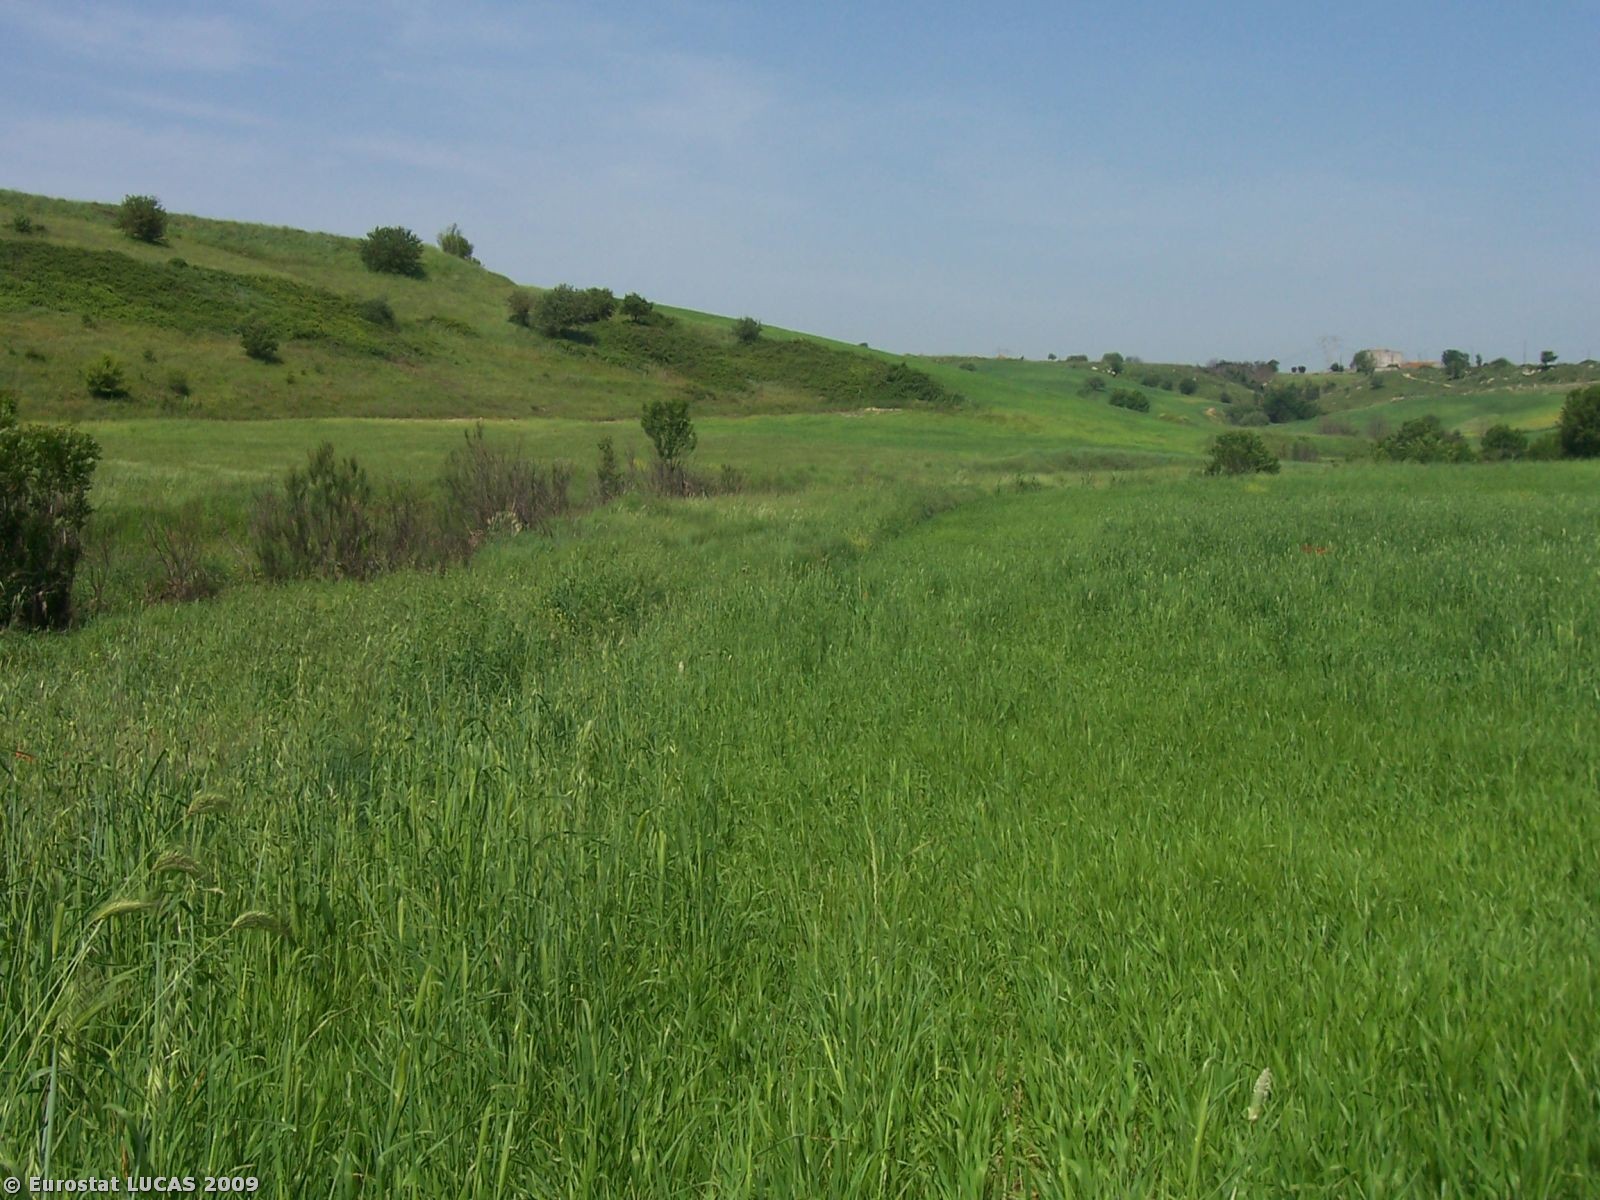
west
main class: Cropland
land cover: Durum wheat
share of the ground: > 75 %
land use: Agriculture (excluding fallow land and kitchen gardens)
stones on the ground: < 10 %
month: May
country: IT
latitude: 40.6631
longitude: 16.8491
